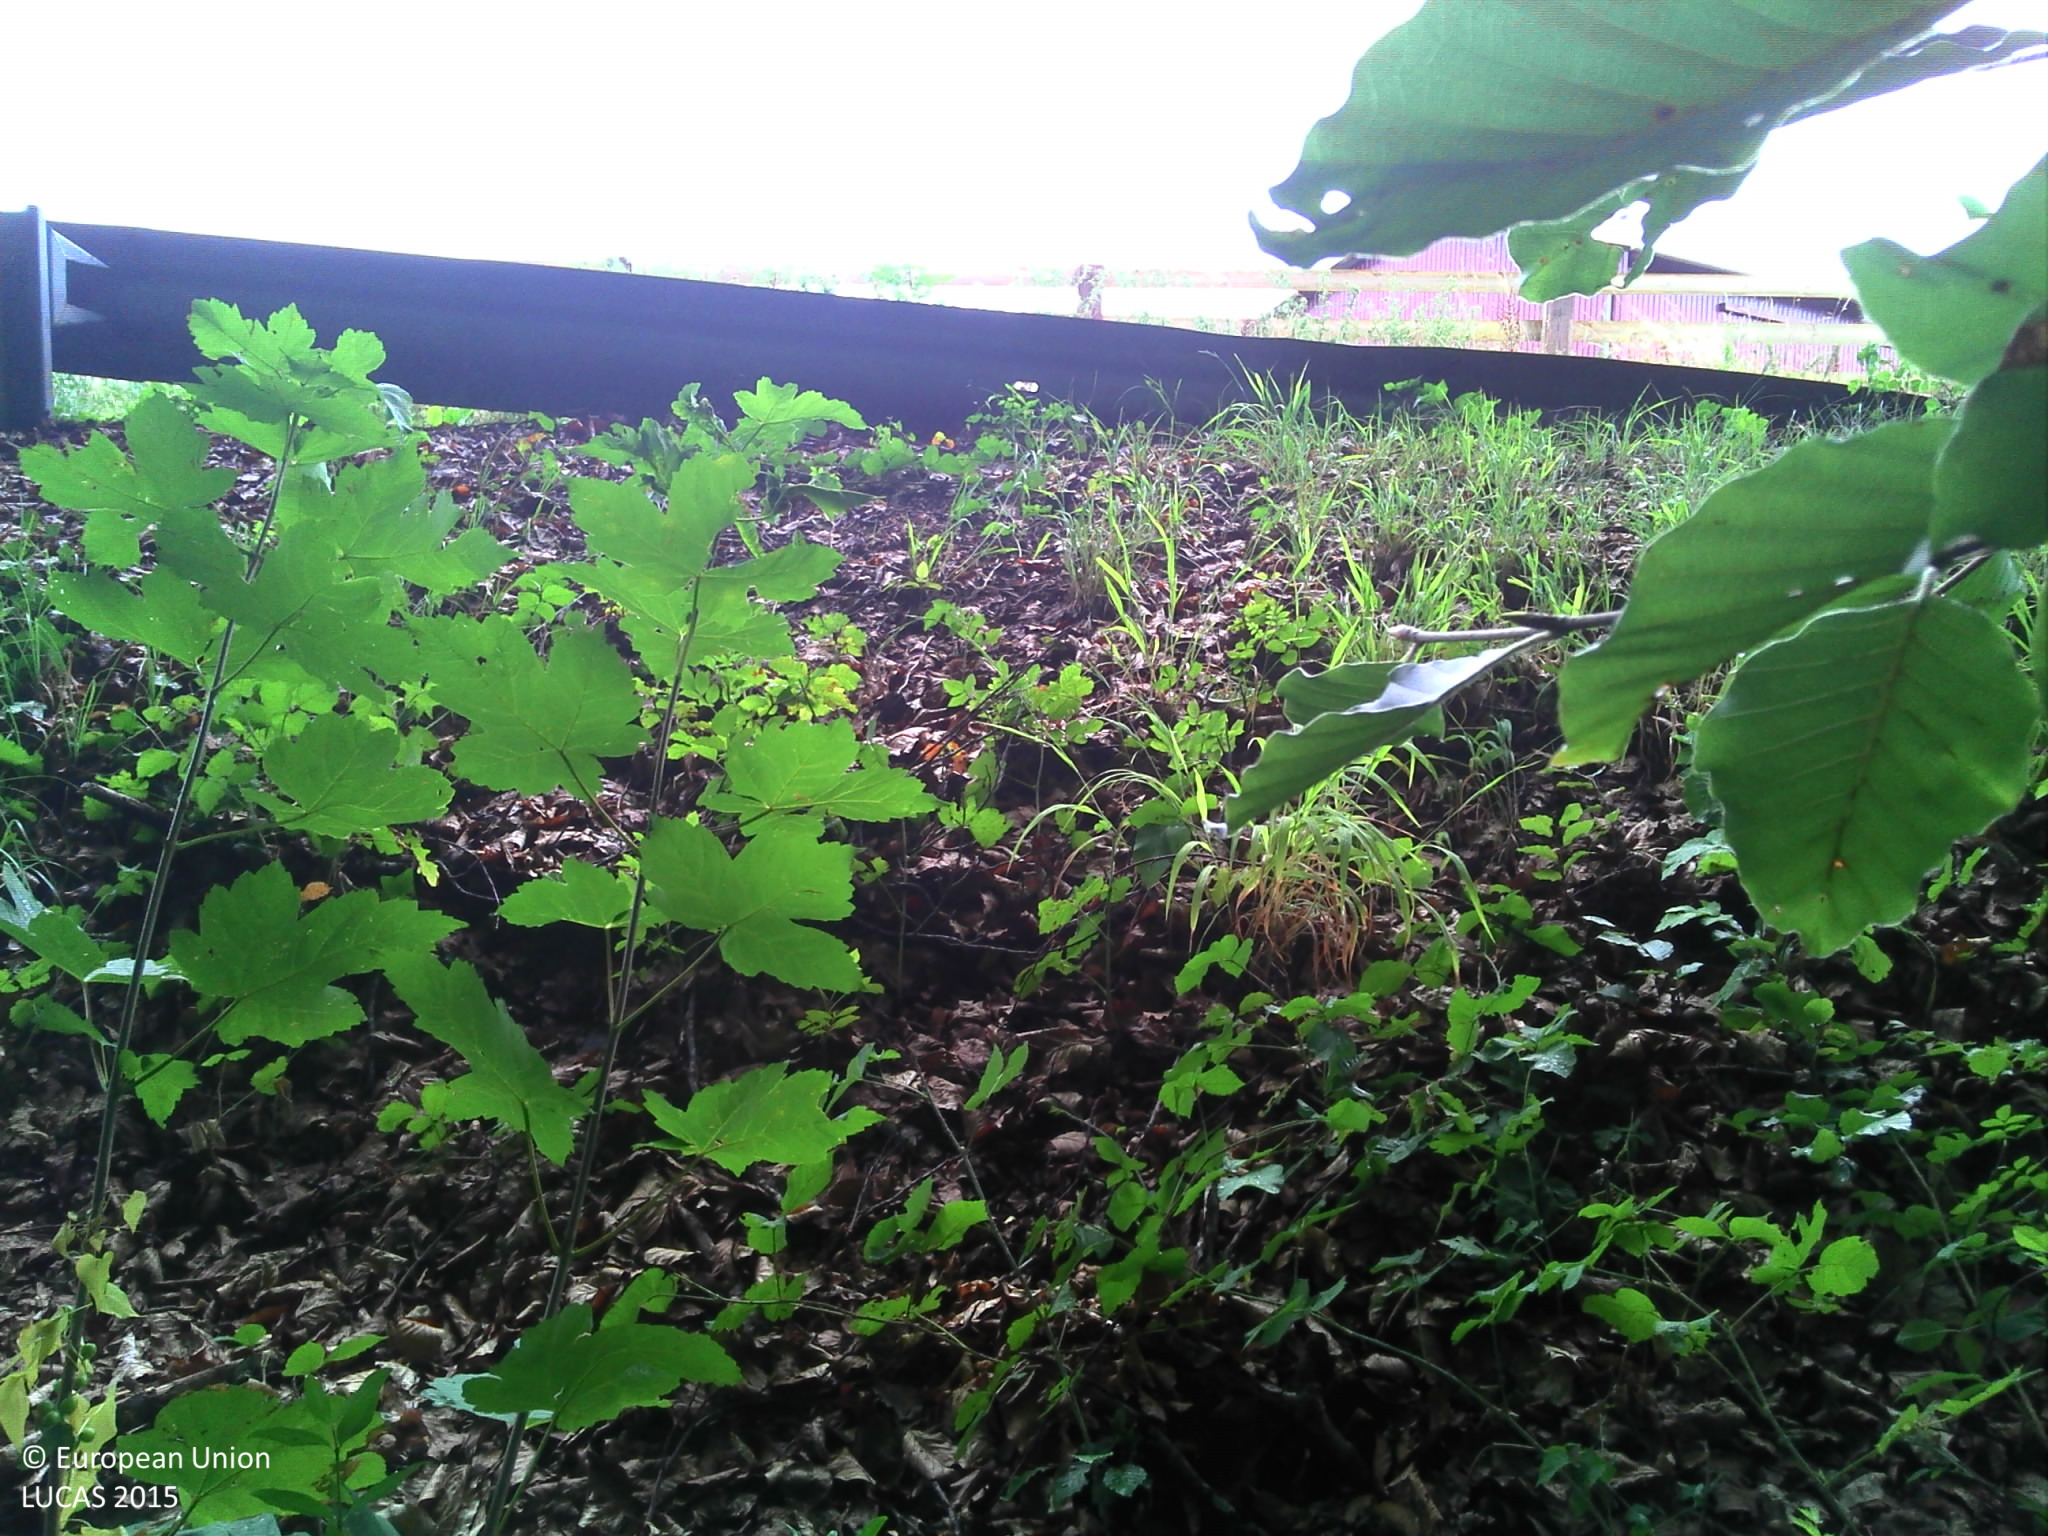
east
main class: Woodland
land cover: Broadleaved woodland
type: beech forest
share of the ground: > 75 %
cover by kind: broadleaved forest trees 70 %, coniferous forest trees 15 %, herbaceous plants 10 %, lichens and mosses 5 %
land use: Forestry
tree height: > 5 m
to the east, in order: Broadleaved woodland; Fences; Paved roads, cycling and walking lanes; Fences; Ditches and canals; Spontaneously vegetated surfaces; Fences; Grassland without tree/shrub cover; Fences; Grassland without tree/shrub cover; Fences; Grassland without tree/shrub cover; Fences; Grassland without tree/shrub cover; Fences; Grassland without tree/shrub cover
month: July
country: FR
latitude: 46.0526
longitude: 6.2943
